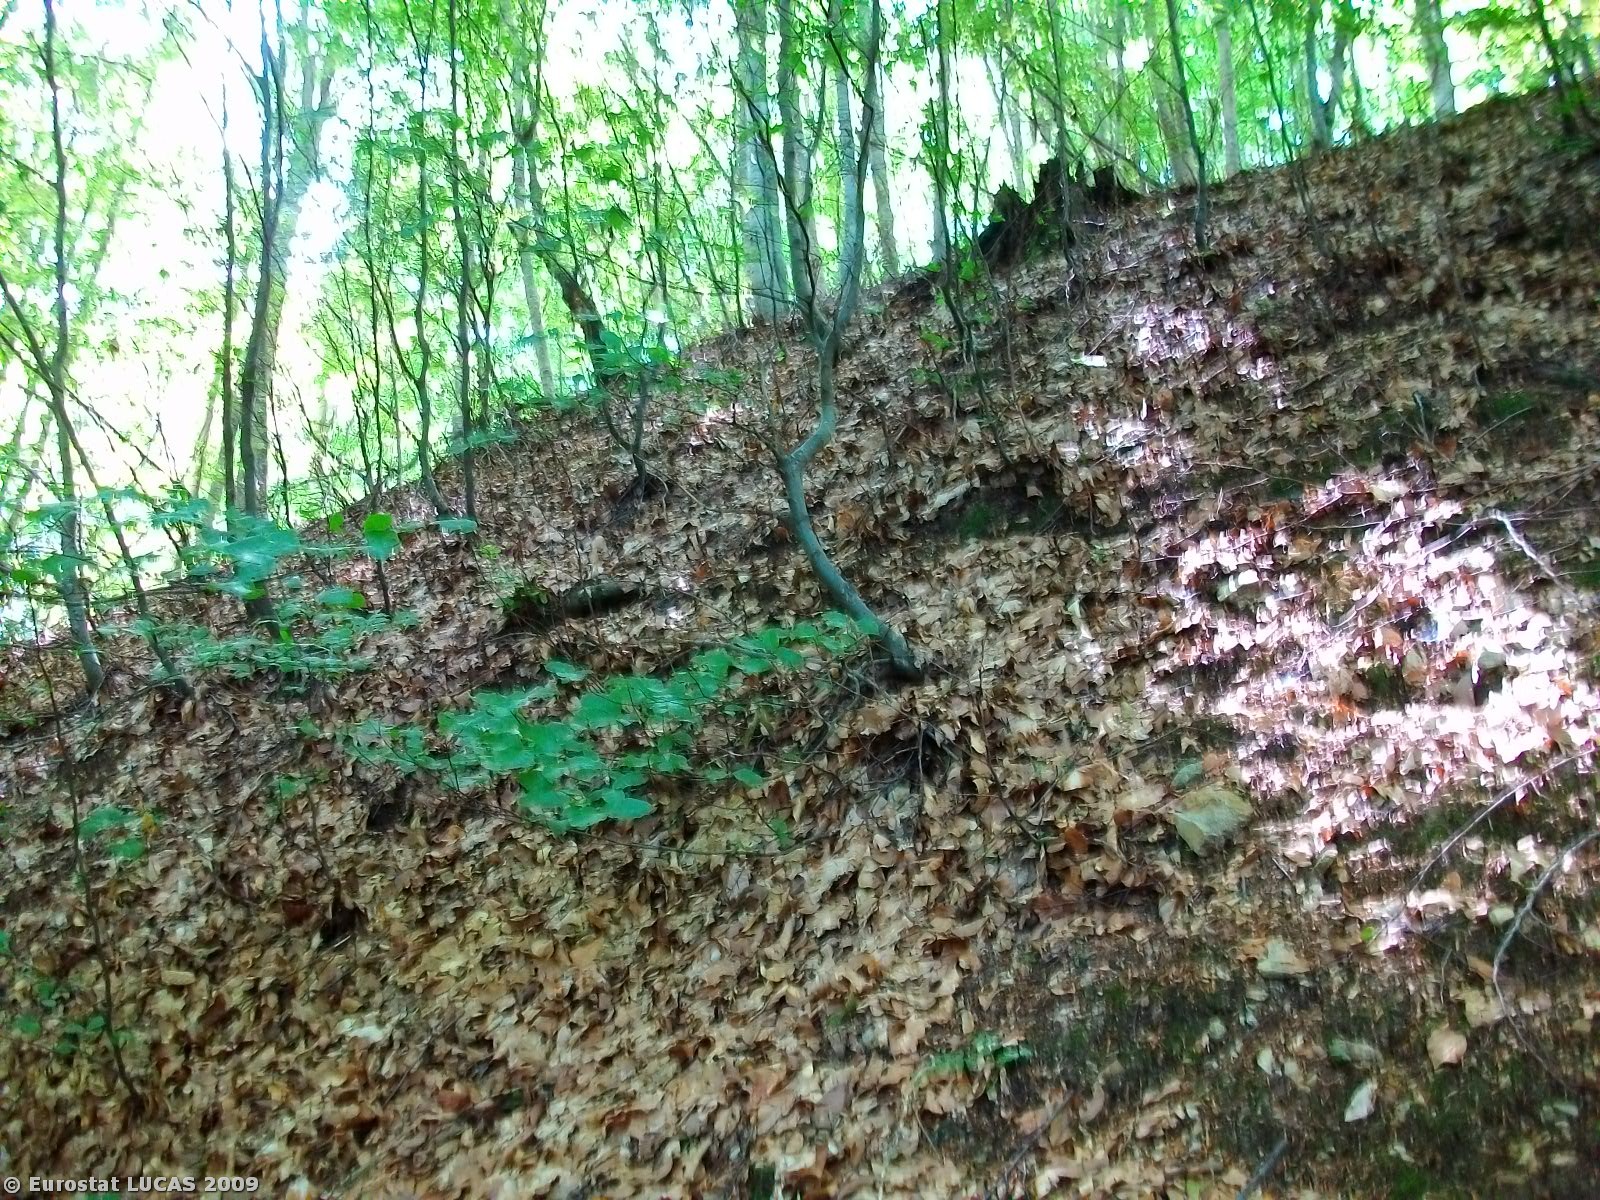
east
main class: Woodland
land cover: Broadleaved woodland
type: thermophilous deciduous forest
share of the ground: > 75 %
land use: Forestry
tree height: > 5 m
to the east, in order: Broadleaved woodland; Paved roads, cycling and walking lanes; Broadleaved woodland; Paved roads, cycling and walking lanes; Broadleaved woodland
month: July
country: GR
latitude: 41.1799
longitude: 24.5197
